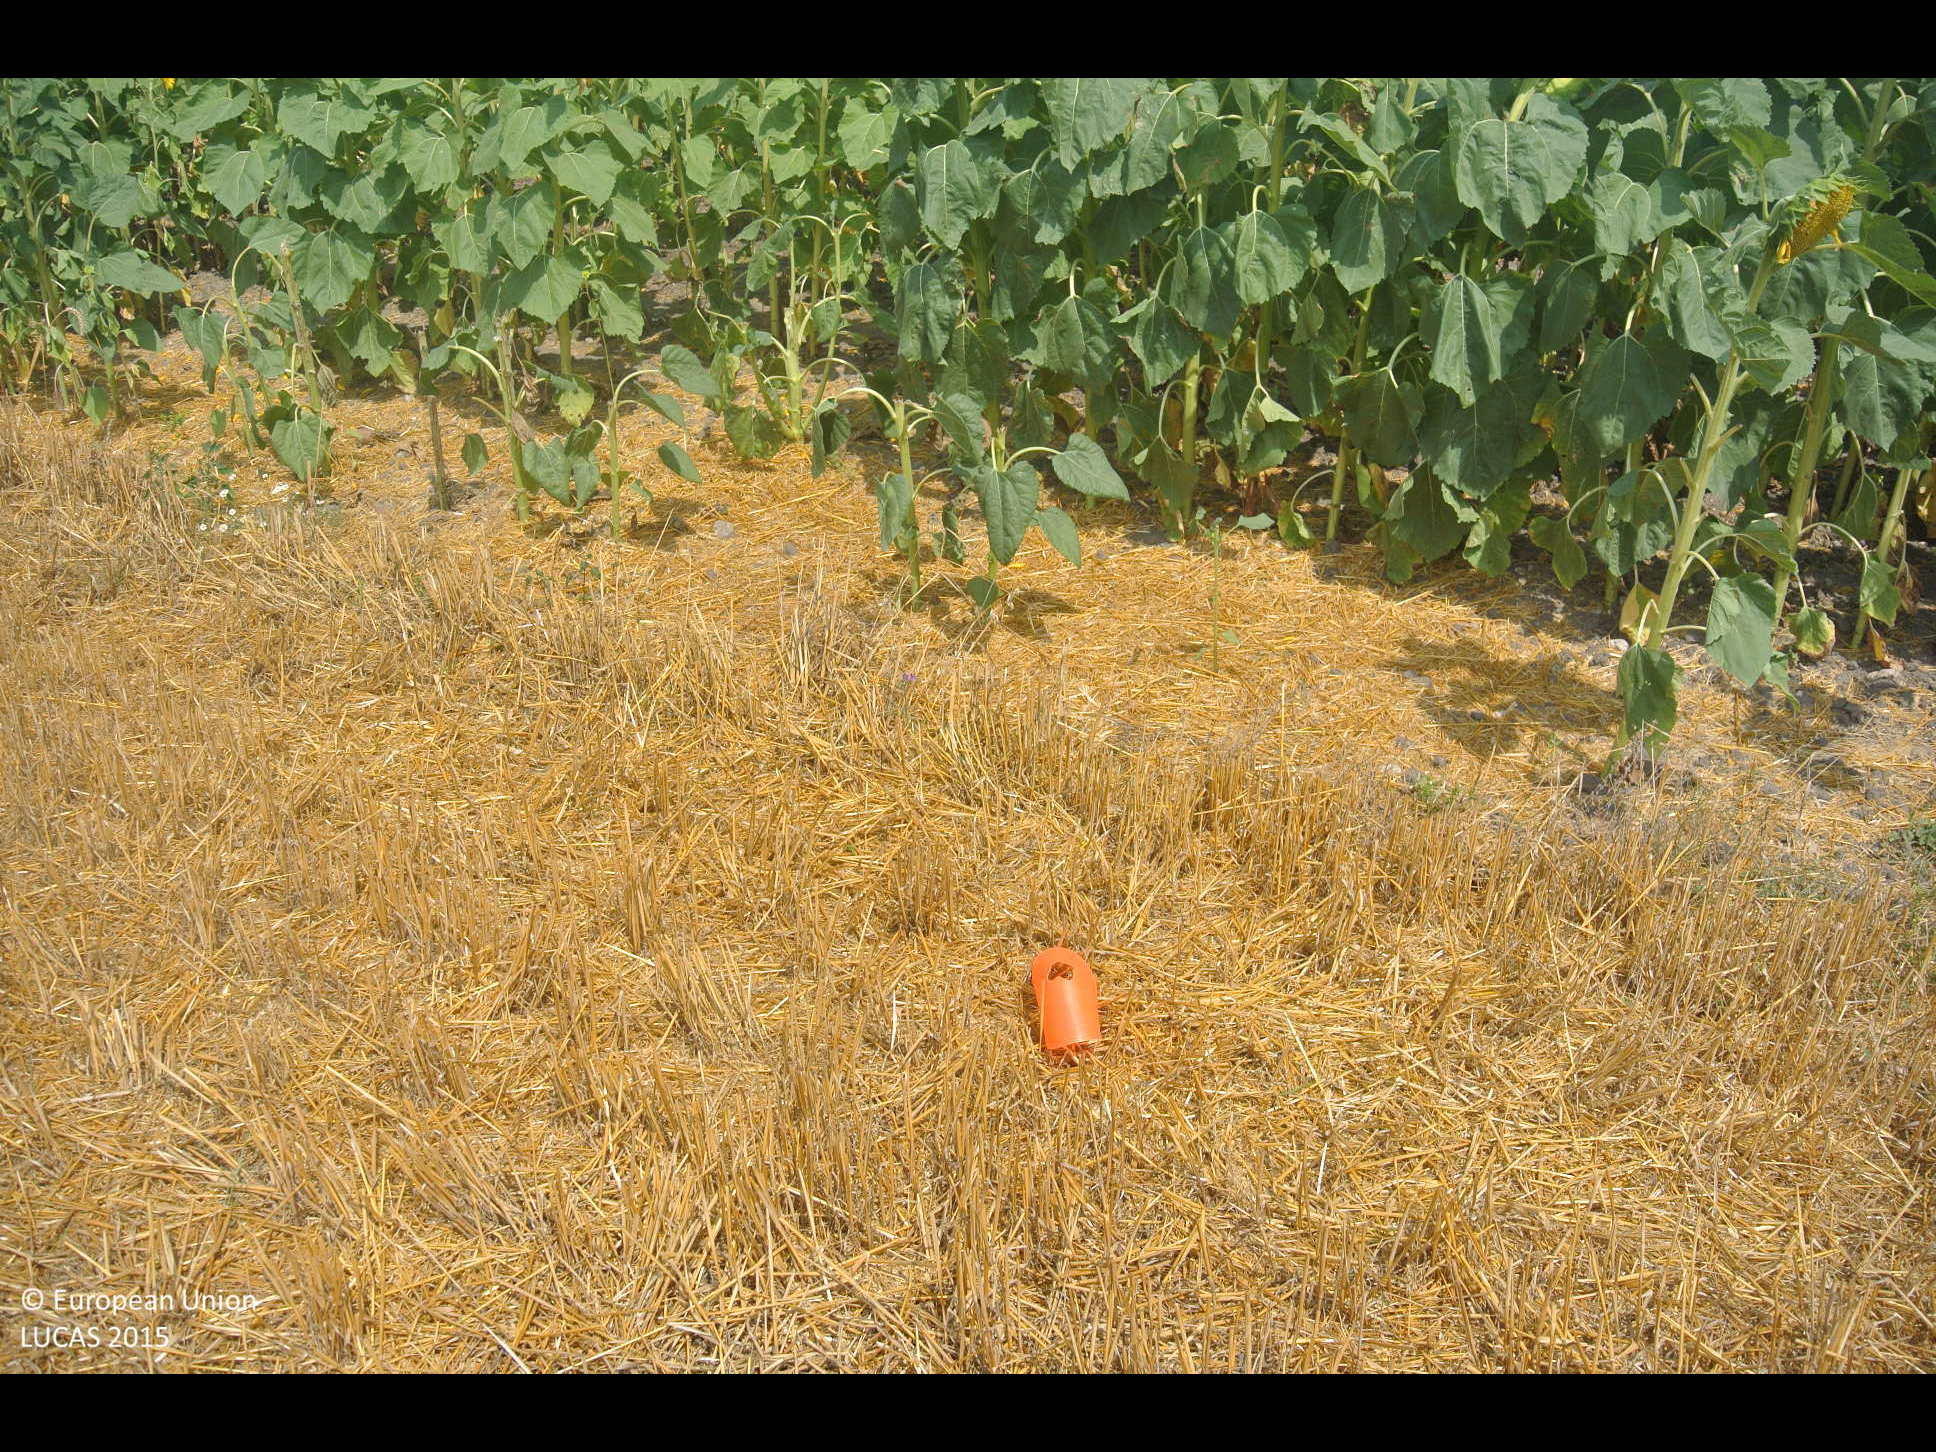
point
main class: Cropland
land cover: Common wheat
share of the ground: > 75 %
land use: Agriculture (excluding fallow land and kitchen gardens)
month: July
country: AT
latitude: 47.7364
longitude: 16.9002
